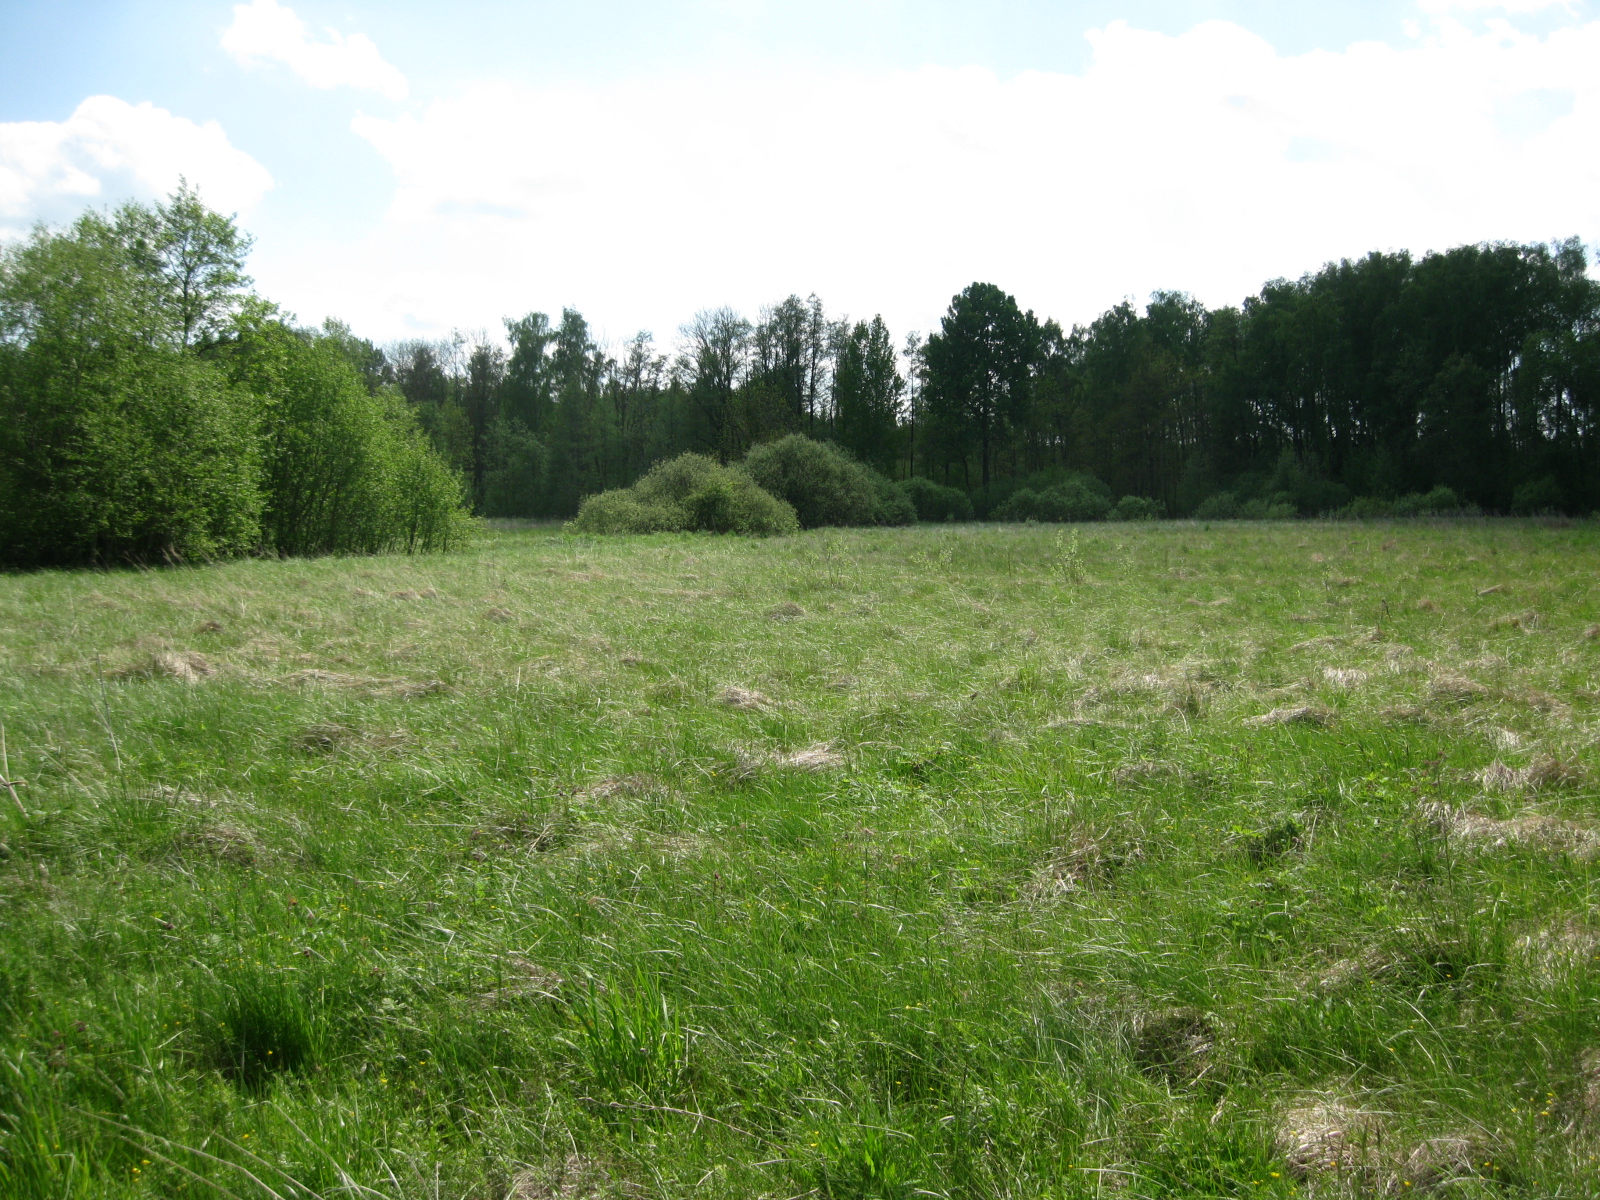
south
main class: Grassland
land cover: Grassland without tree/shrub cover
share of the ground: > 75 %
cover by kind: herbaceous plants 100 %
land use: Agriculture (excluding fallow land and kitchen gardens)
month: May
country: LT
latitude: 56.0399
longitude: 24.1348
